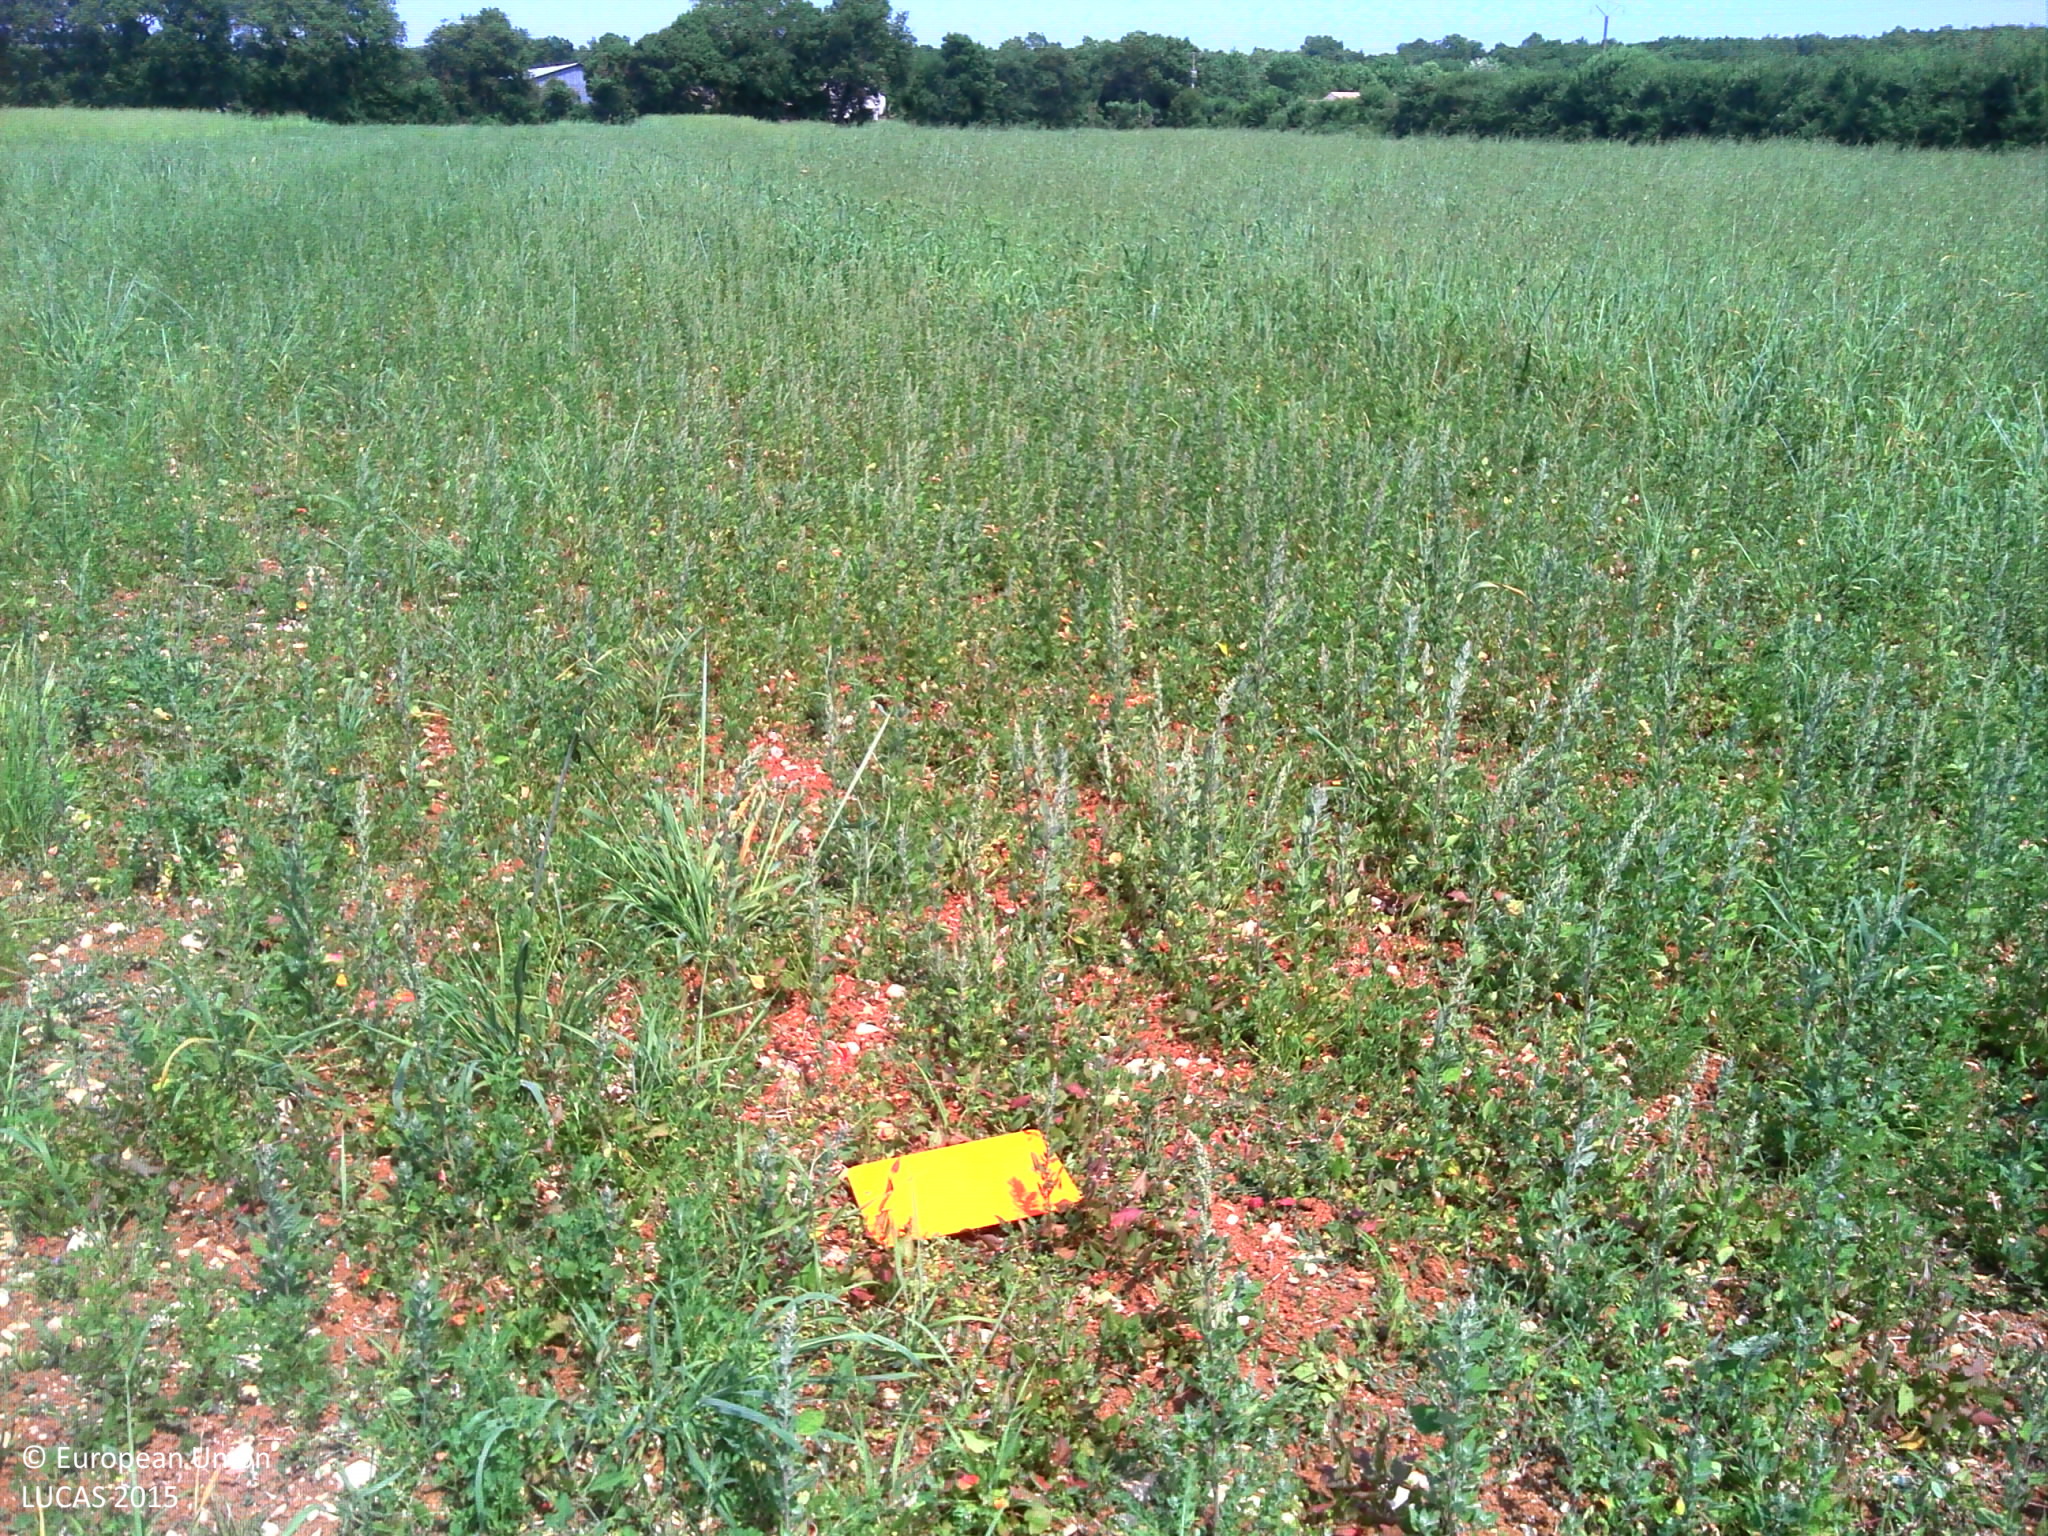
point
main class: Grassland
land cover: Spontaneously vegetated surfaces
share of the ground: > 75 %
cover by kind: herbaceous plants 95 %, shrubs 5 %
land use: Fallow land
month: June
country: FR
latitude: 46.1874
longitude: -0.7685
